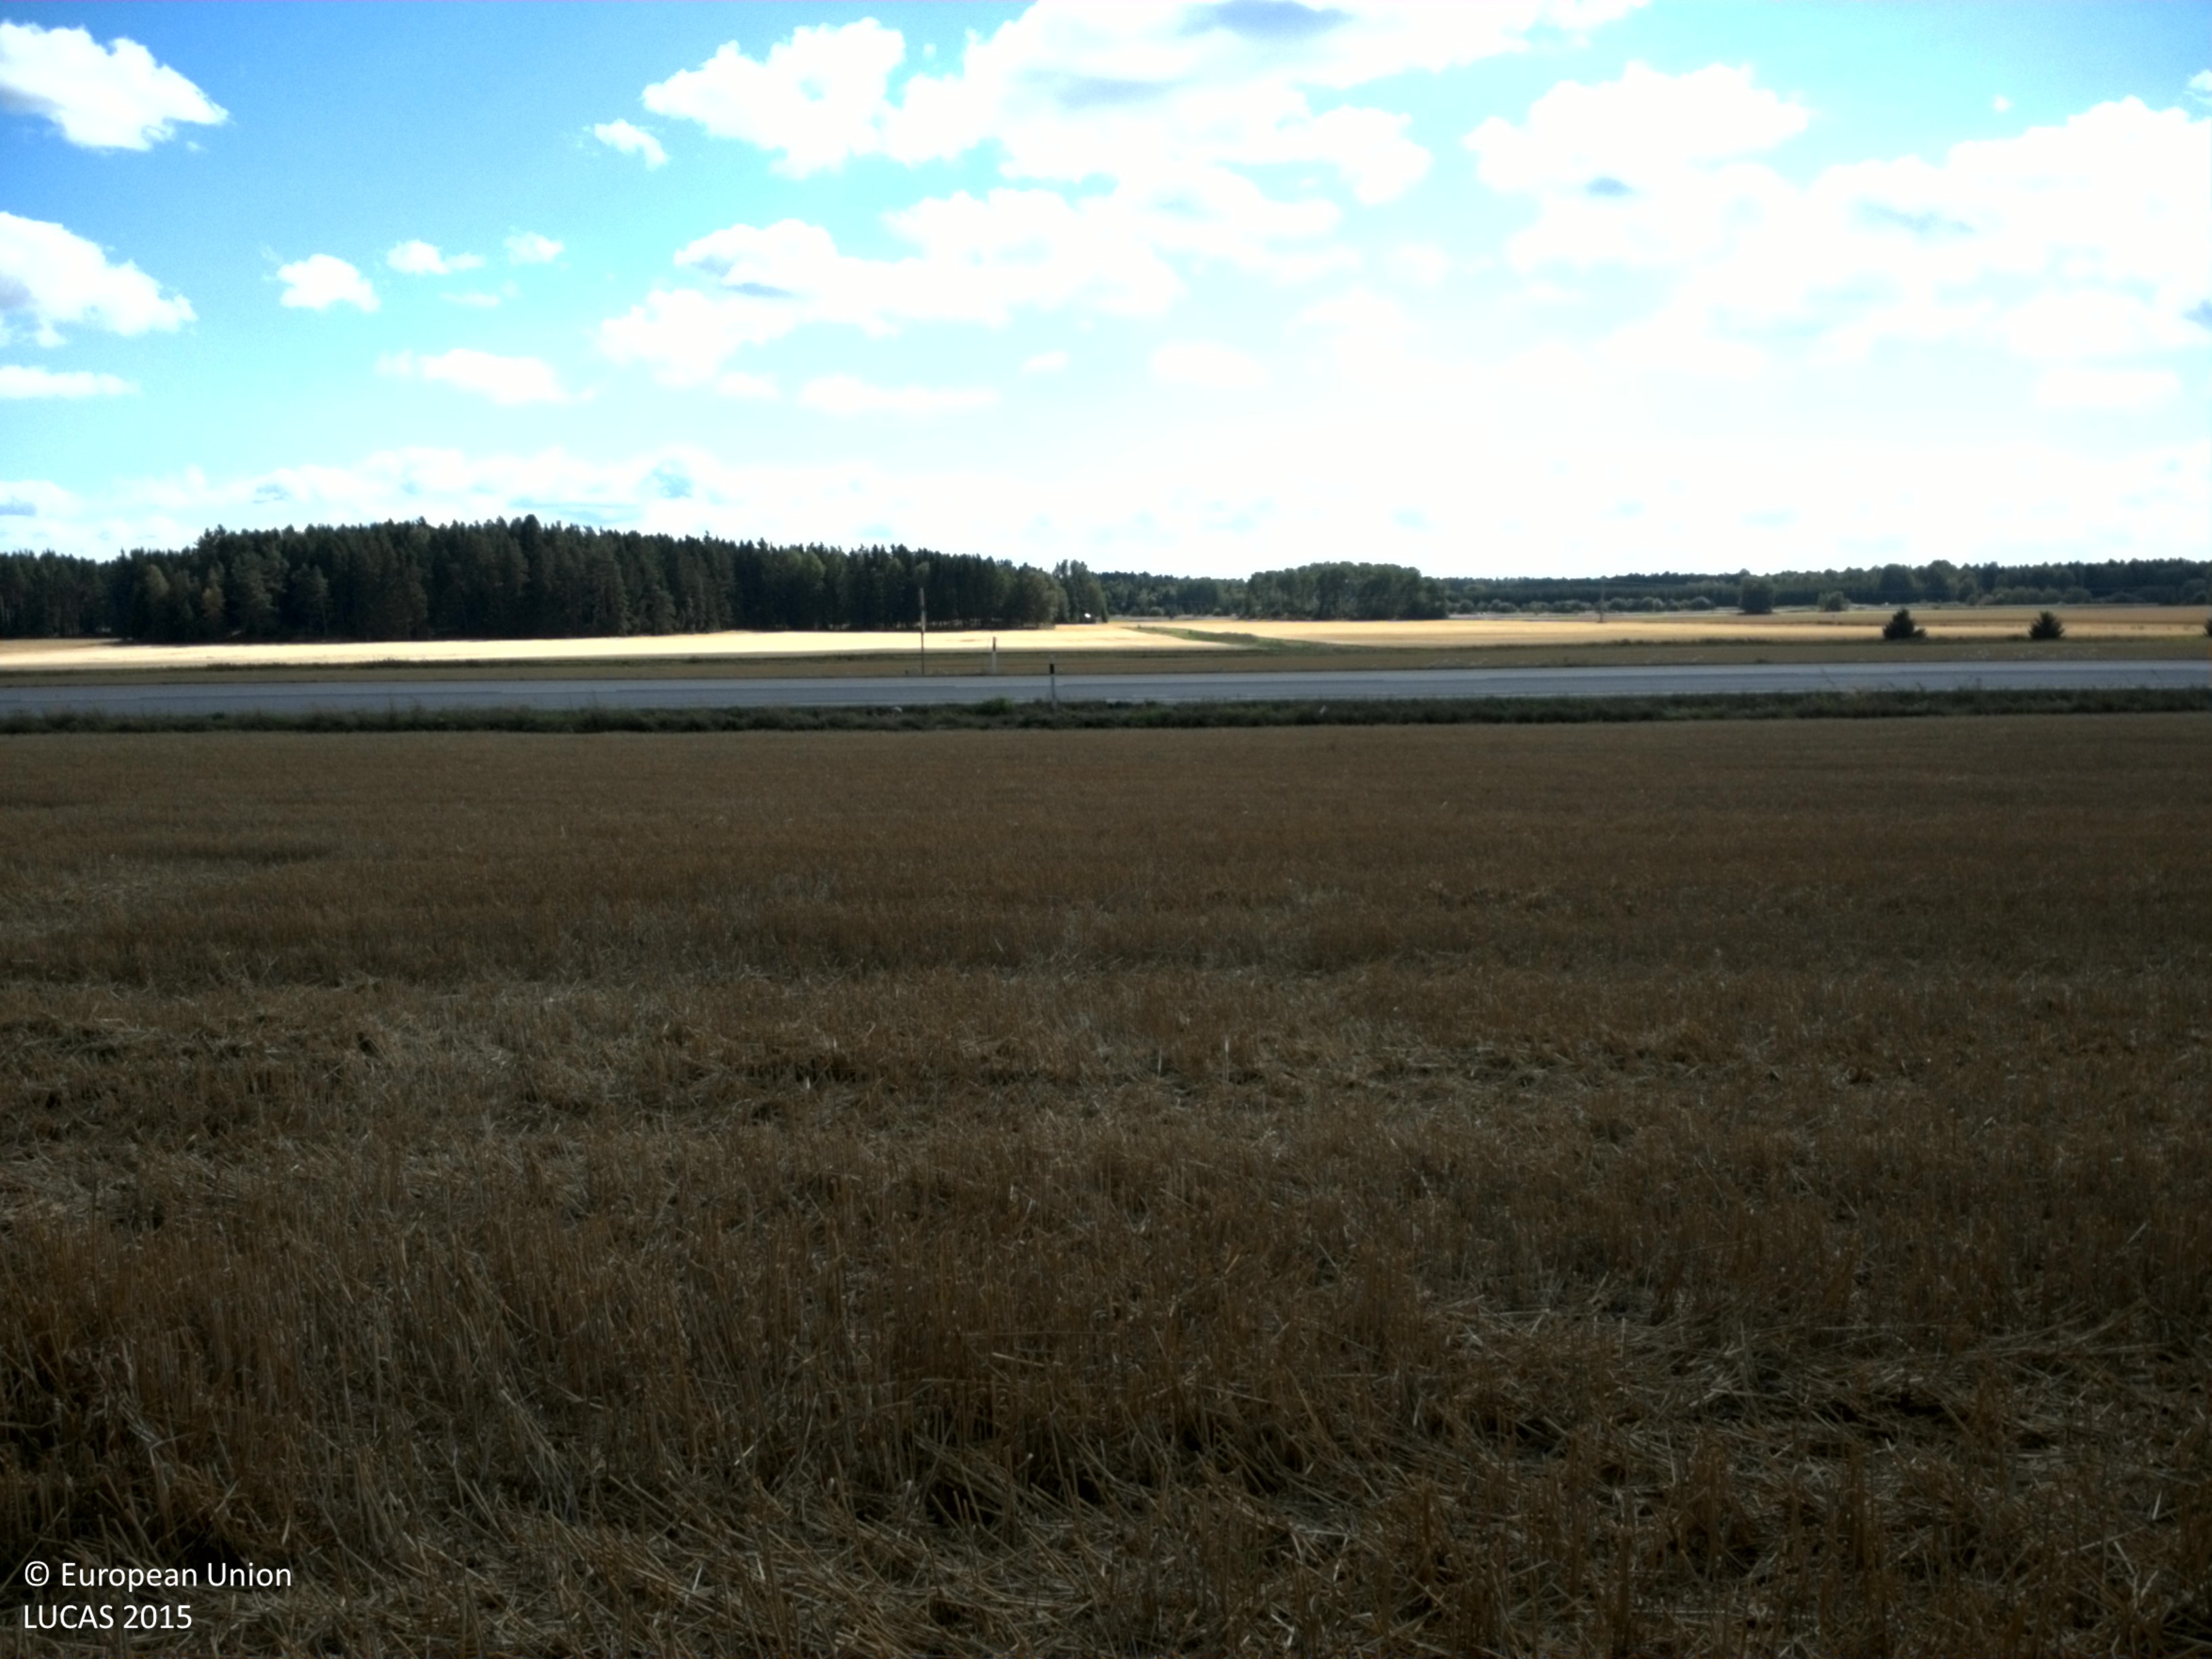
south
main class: Cropland
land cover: Common wheat
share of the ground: > 75 %
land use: Agriculture (excluding fallow land and kitchen gardens)
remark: Harvested field
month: August
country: SE
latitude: 59.6541
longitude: 17.1805
